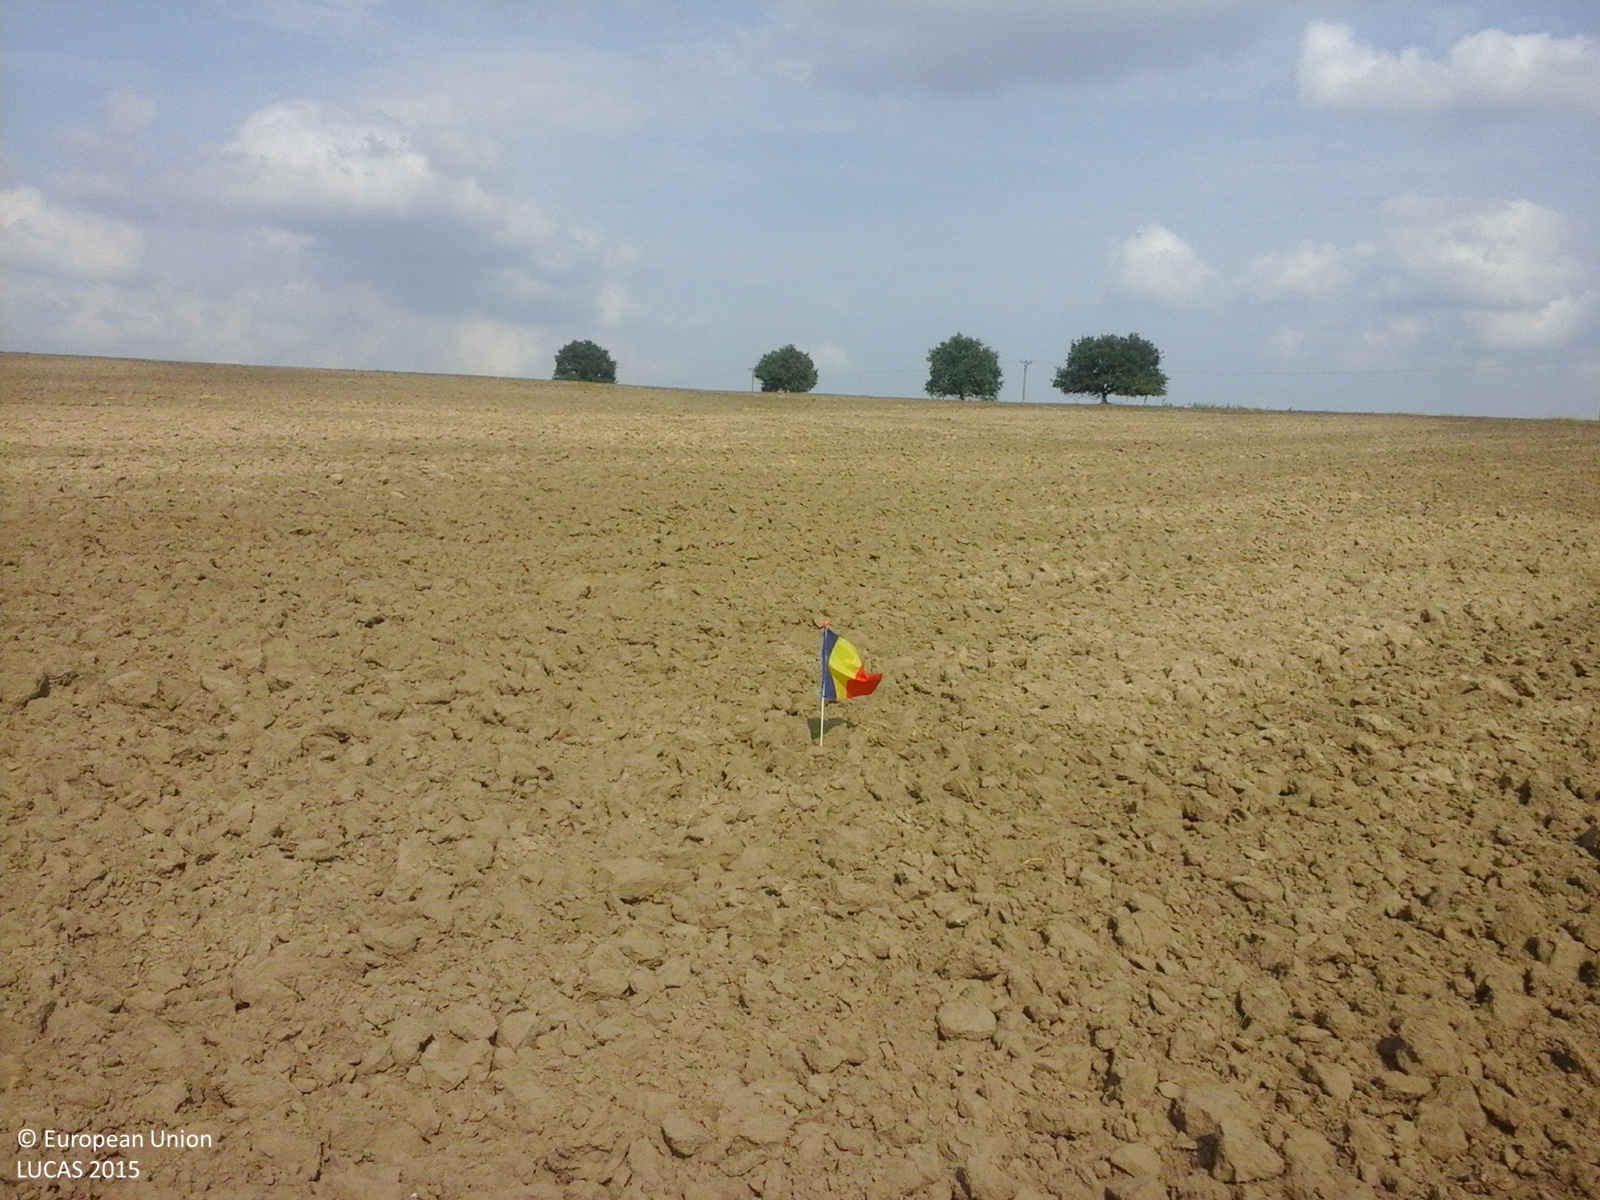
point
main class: Cropland
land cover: Common wheat
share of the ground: < 10 %
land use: Agriculture (excluding fallow land and kitchen gardens)
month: July
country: RO
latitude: 45.0164
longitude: 28.3854
